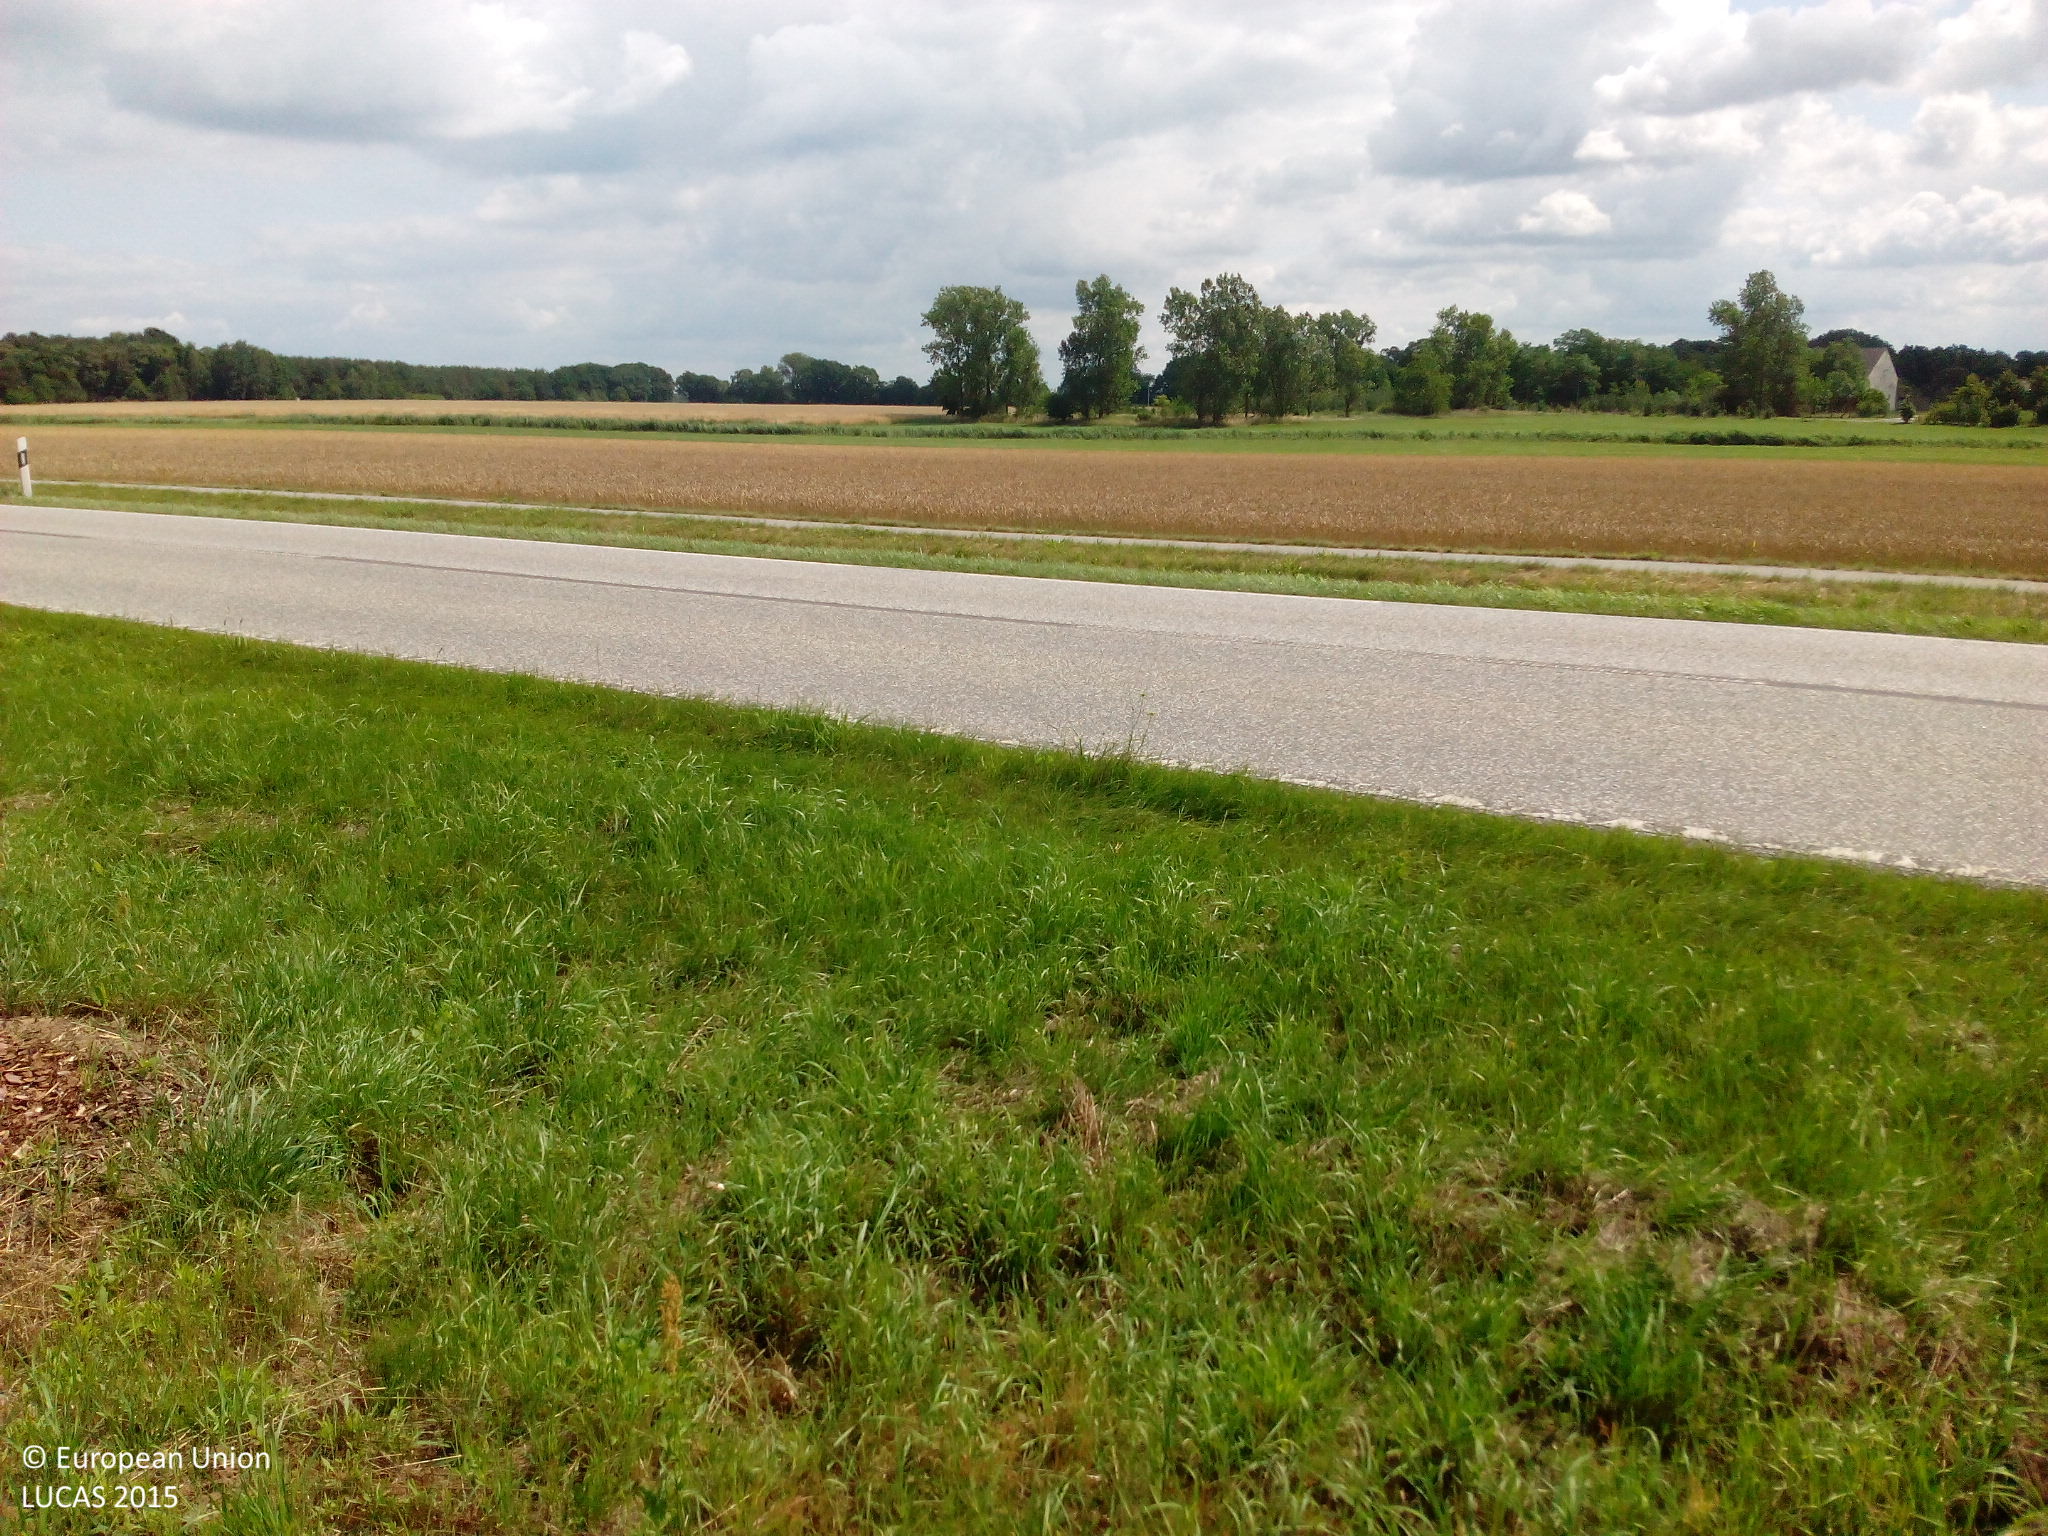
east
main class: Cropland
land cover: Rye
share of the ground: > 75 %
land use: Agriculture (excluding fallow land and kitchen gardens)
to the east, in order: Rye; Lines of trees; Grassland without tree/shrub cover; Paved roads, cycling and walking lanes; Ditches and canals; Paved roads, cycling and walking lanes; Grass margins; Lines of trees; Grassland without tree/shrub cover; Ditches and canals; Grassland without tree/shrub cover
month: July
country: DE
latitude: 52.6779
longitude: 12.3512
